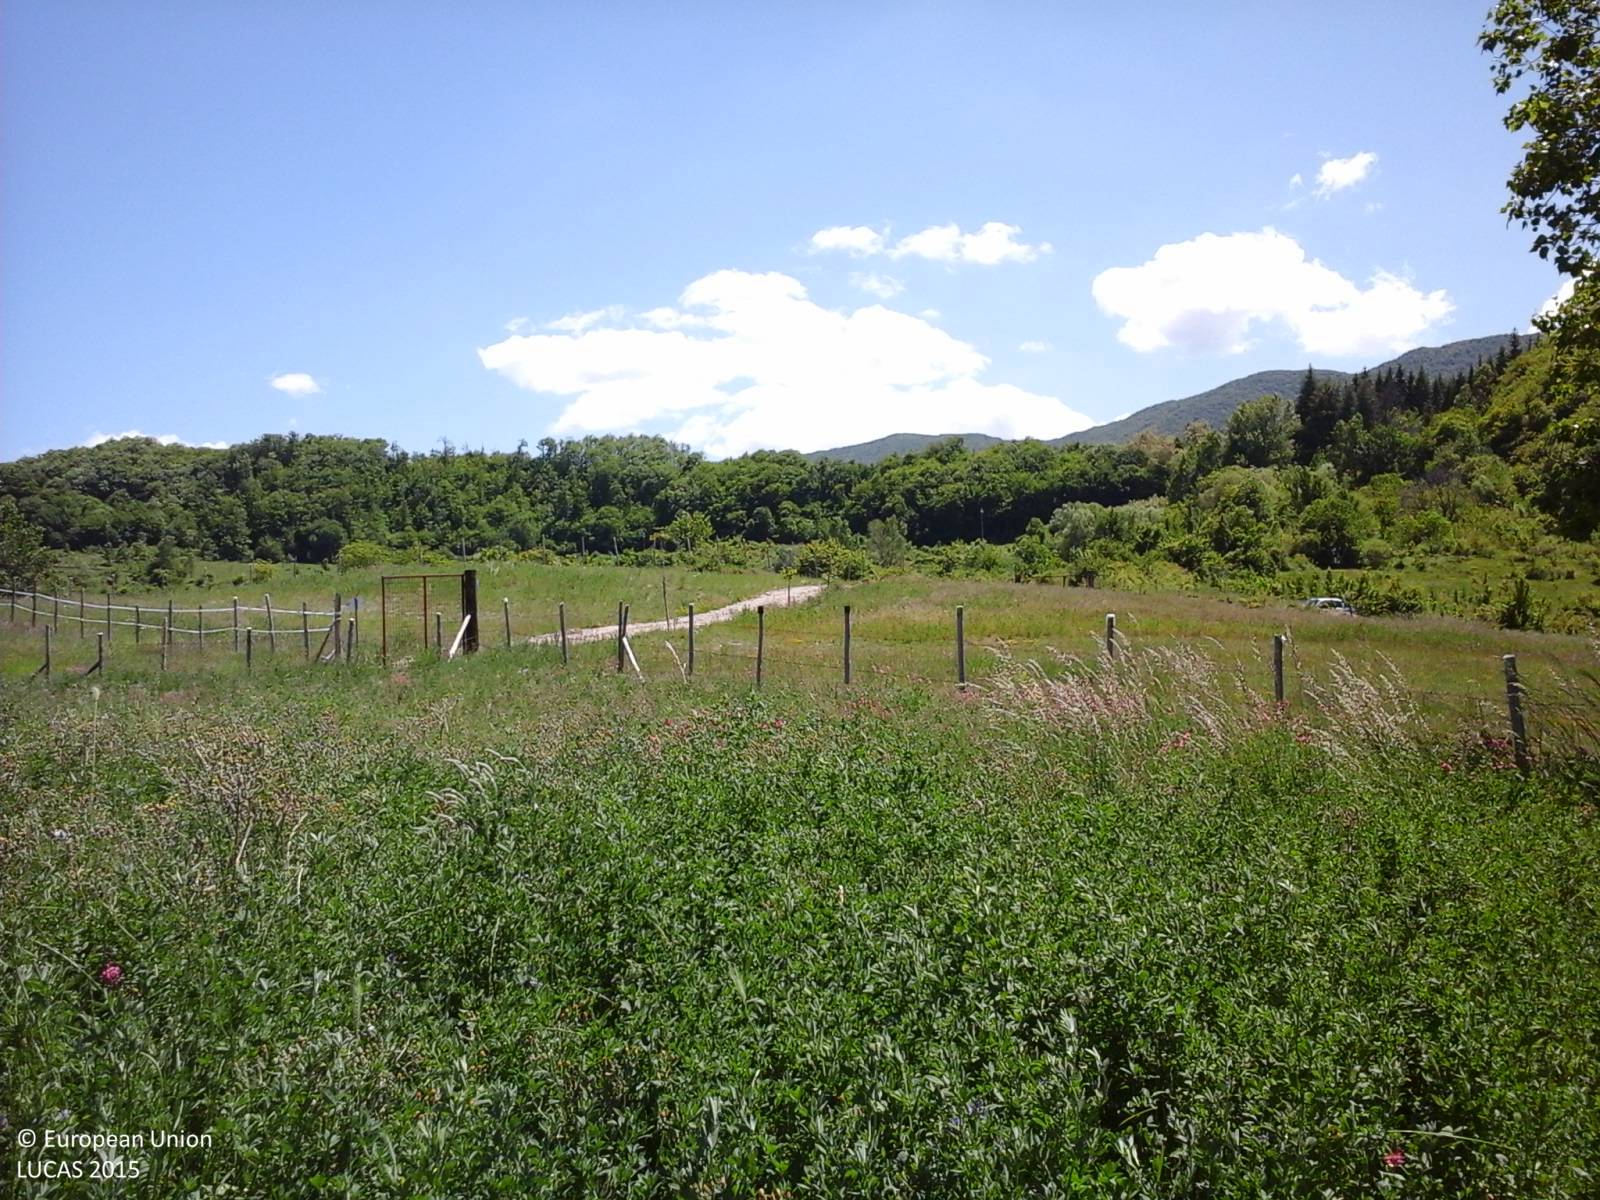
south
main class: Cropland
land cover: Lucerne
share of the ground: > 75 %
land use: Agriculture (excluding fallow land and kitchen gardens)
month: May
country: IT
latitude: 42.0787
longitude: 13.2163
